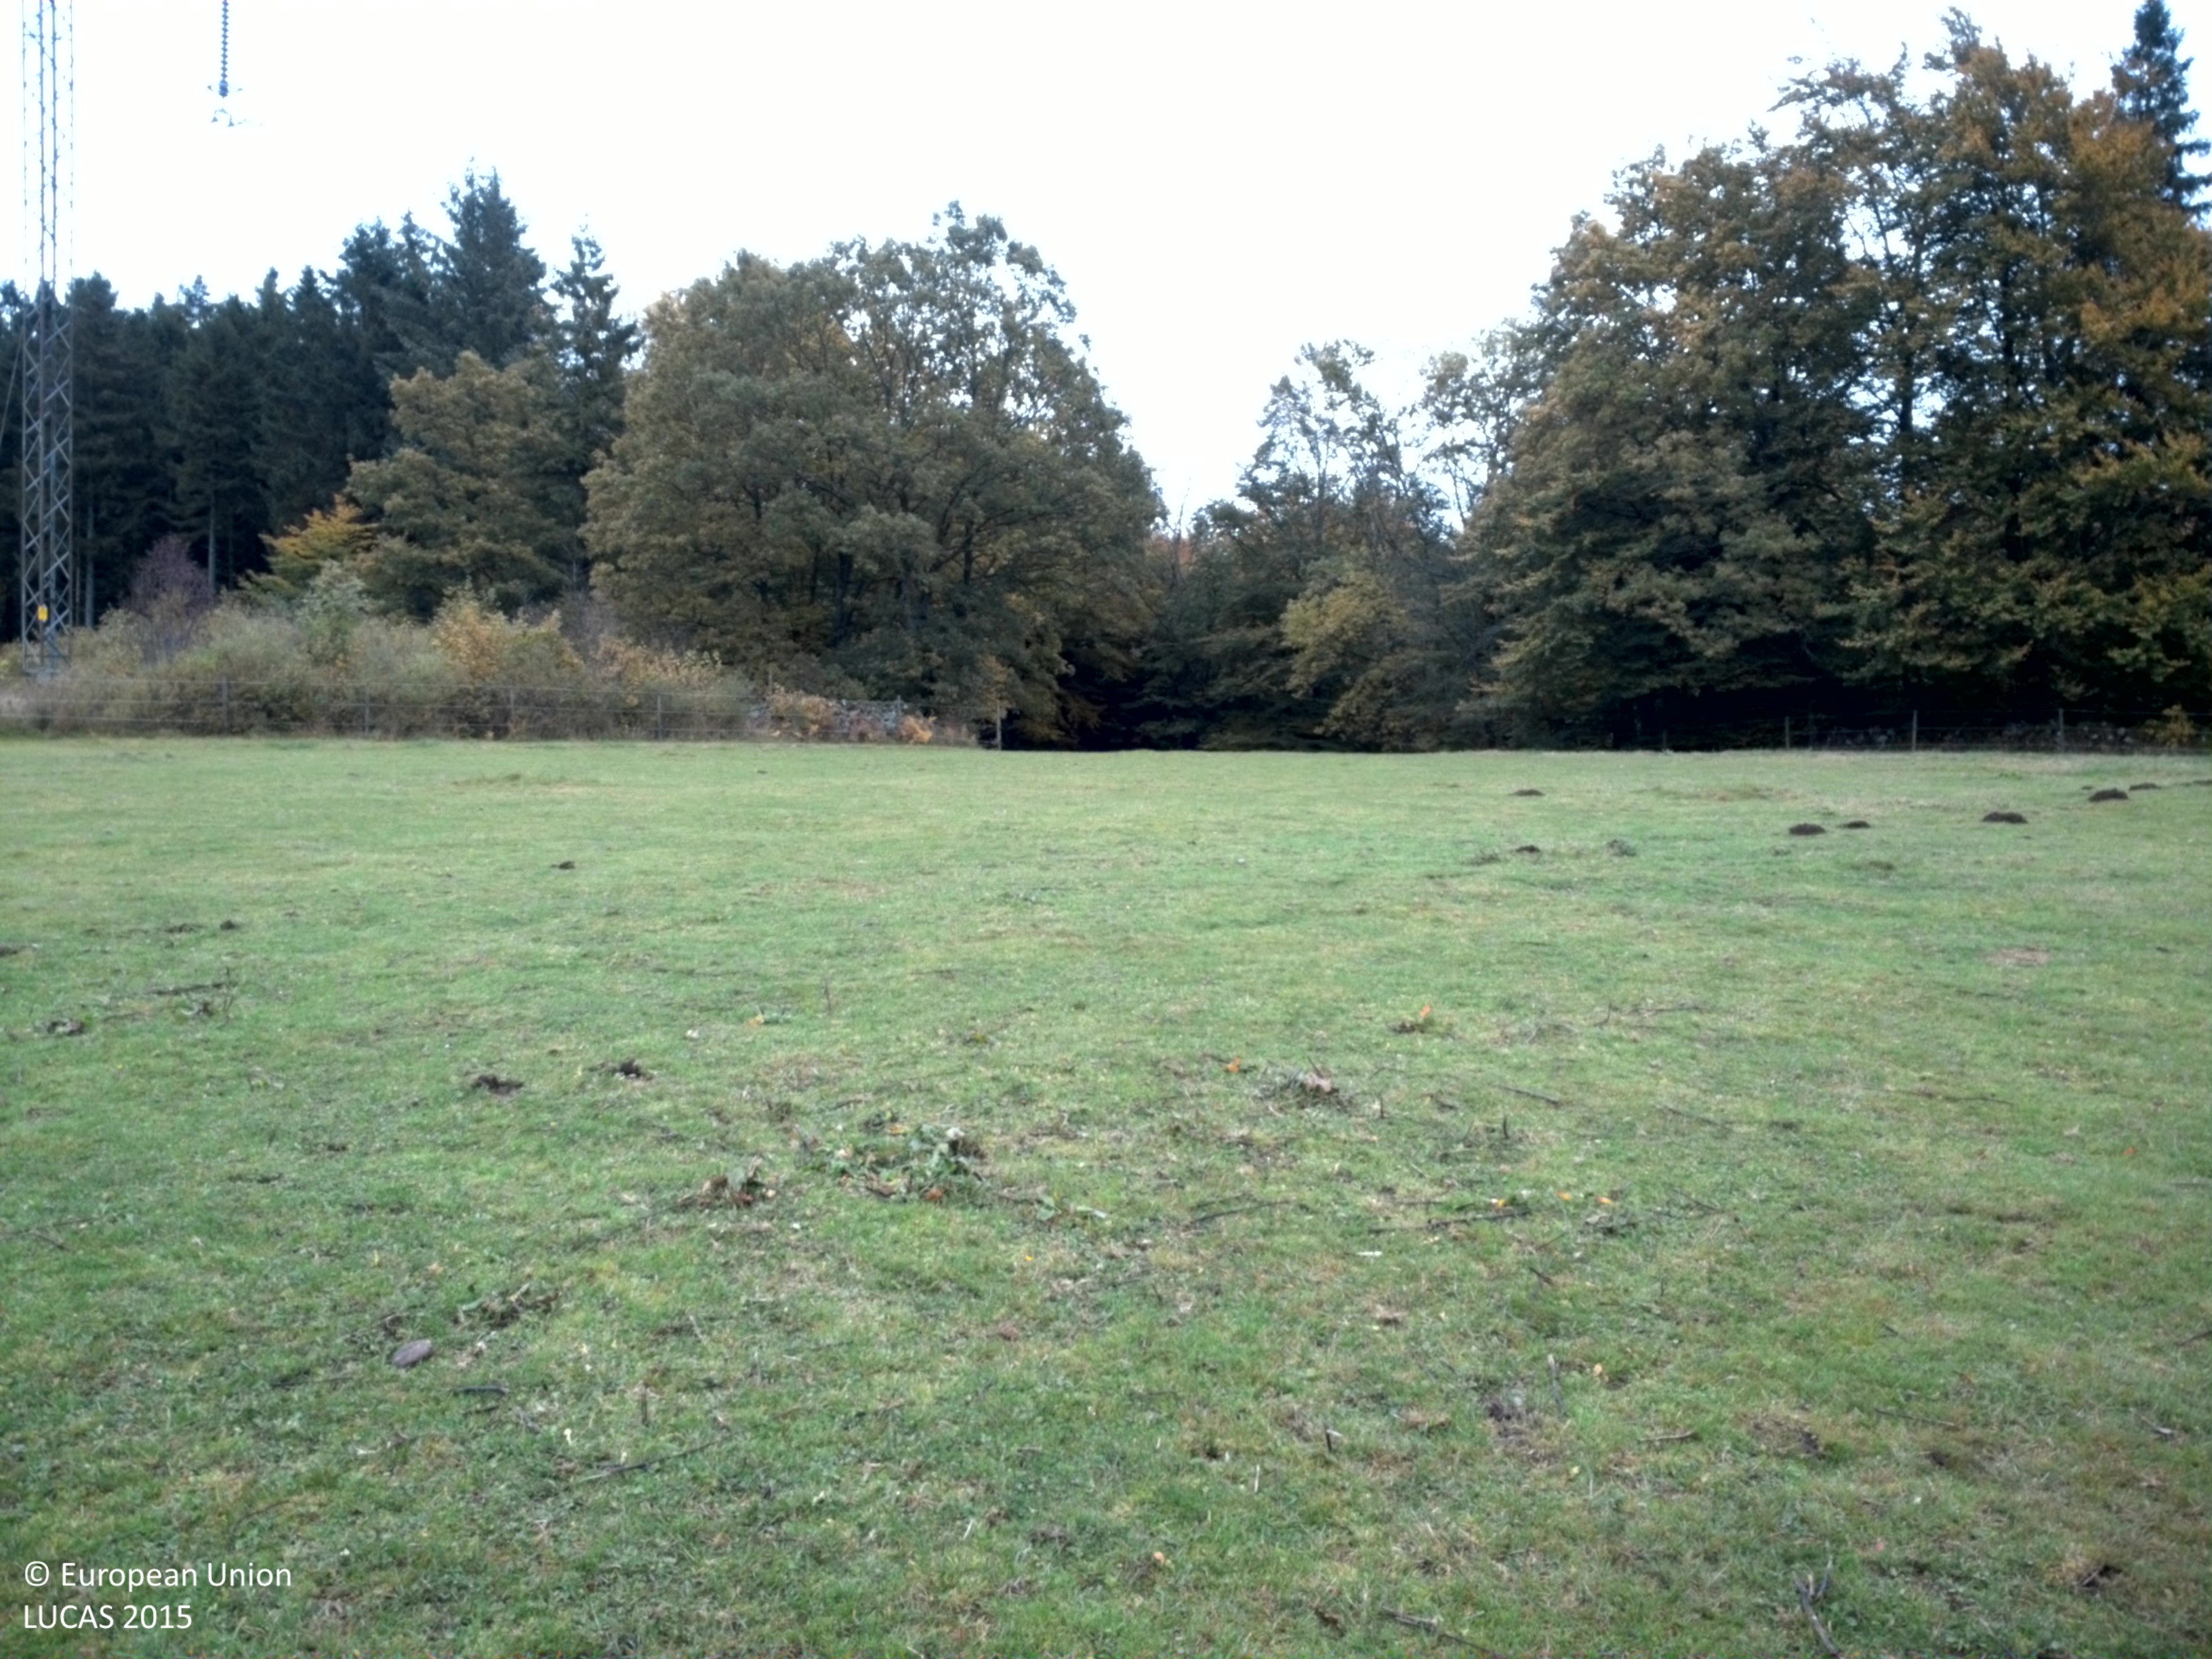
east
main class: Grassland
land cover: Grassland without tree/shrub cover
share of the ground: > 75 %
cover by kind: herbaceous plants 100 %
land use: Agriculture (excluding fallow land and kitchen gardens)
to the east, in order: Grassland without tree/shrub cover; Electric lines; Grassland without tree/shrub cover; Fences; Dry stone walls; Broadleaved woodland
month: October
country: SE
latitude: 55.8828
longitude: 13.6907
